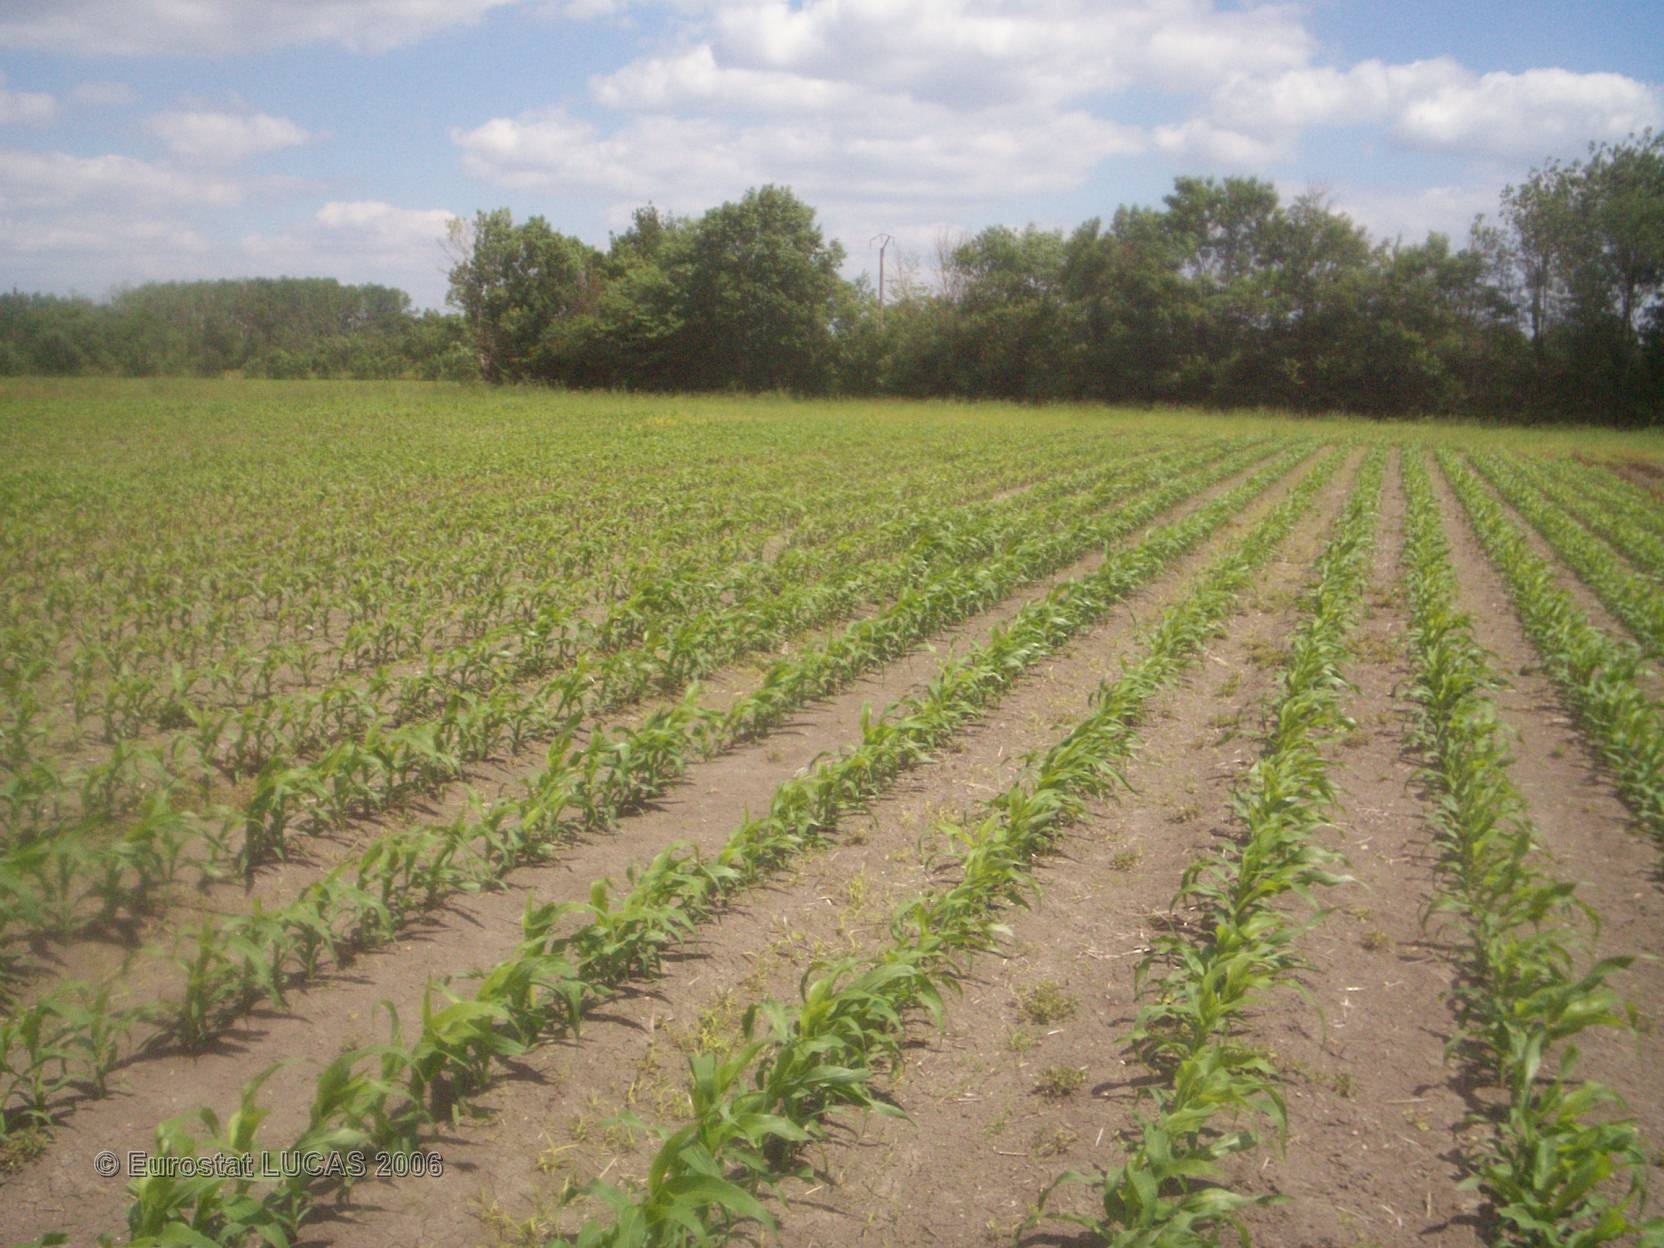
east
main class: Cropland
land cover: Maize
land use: Agriculture (excluding fallow land and kitchen gardens)
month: May
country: FR
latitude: 45.9100
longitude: -0.8171
